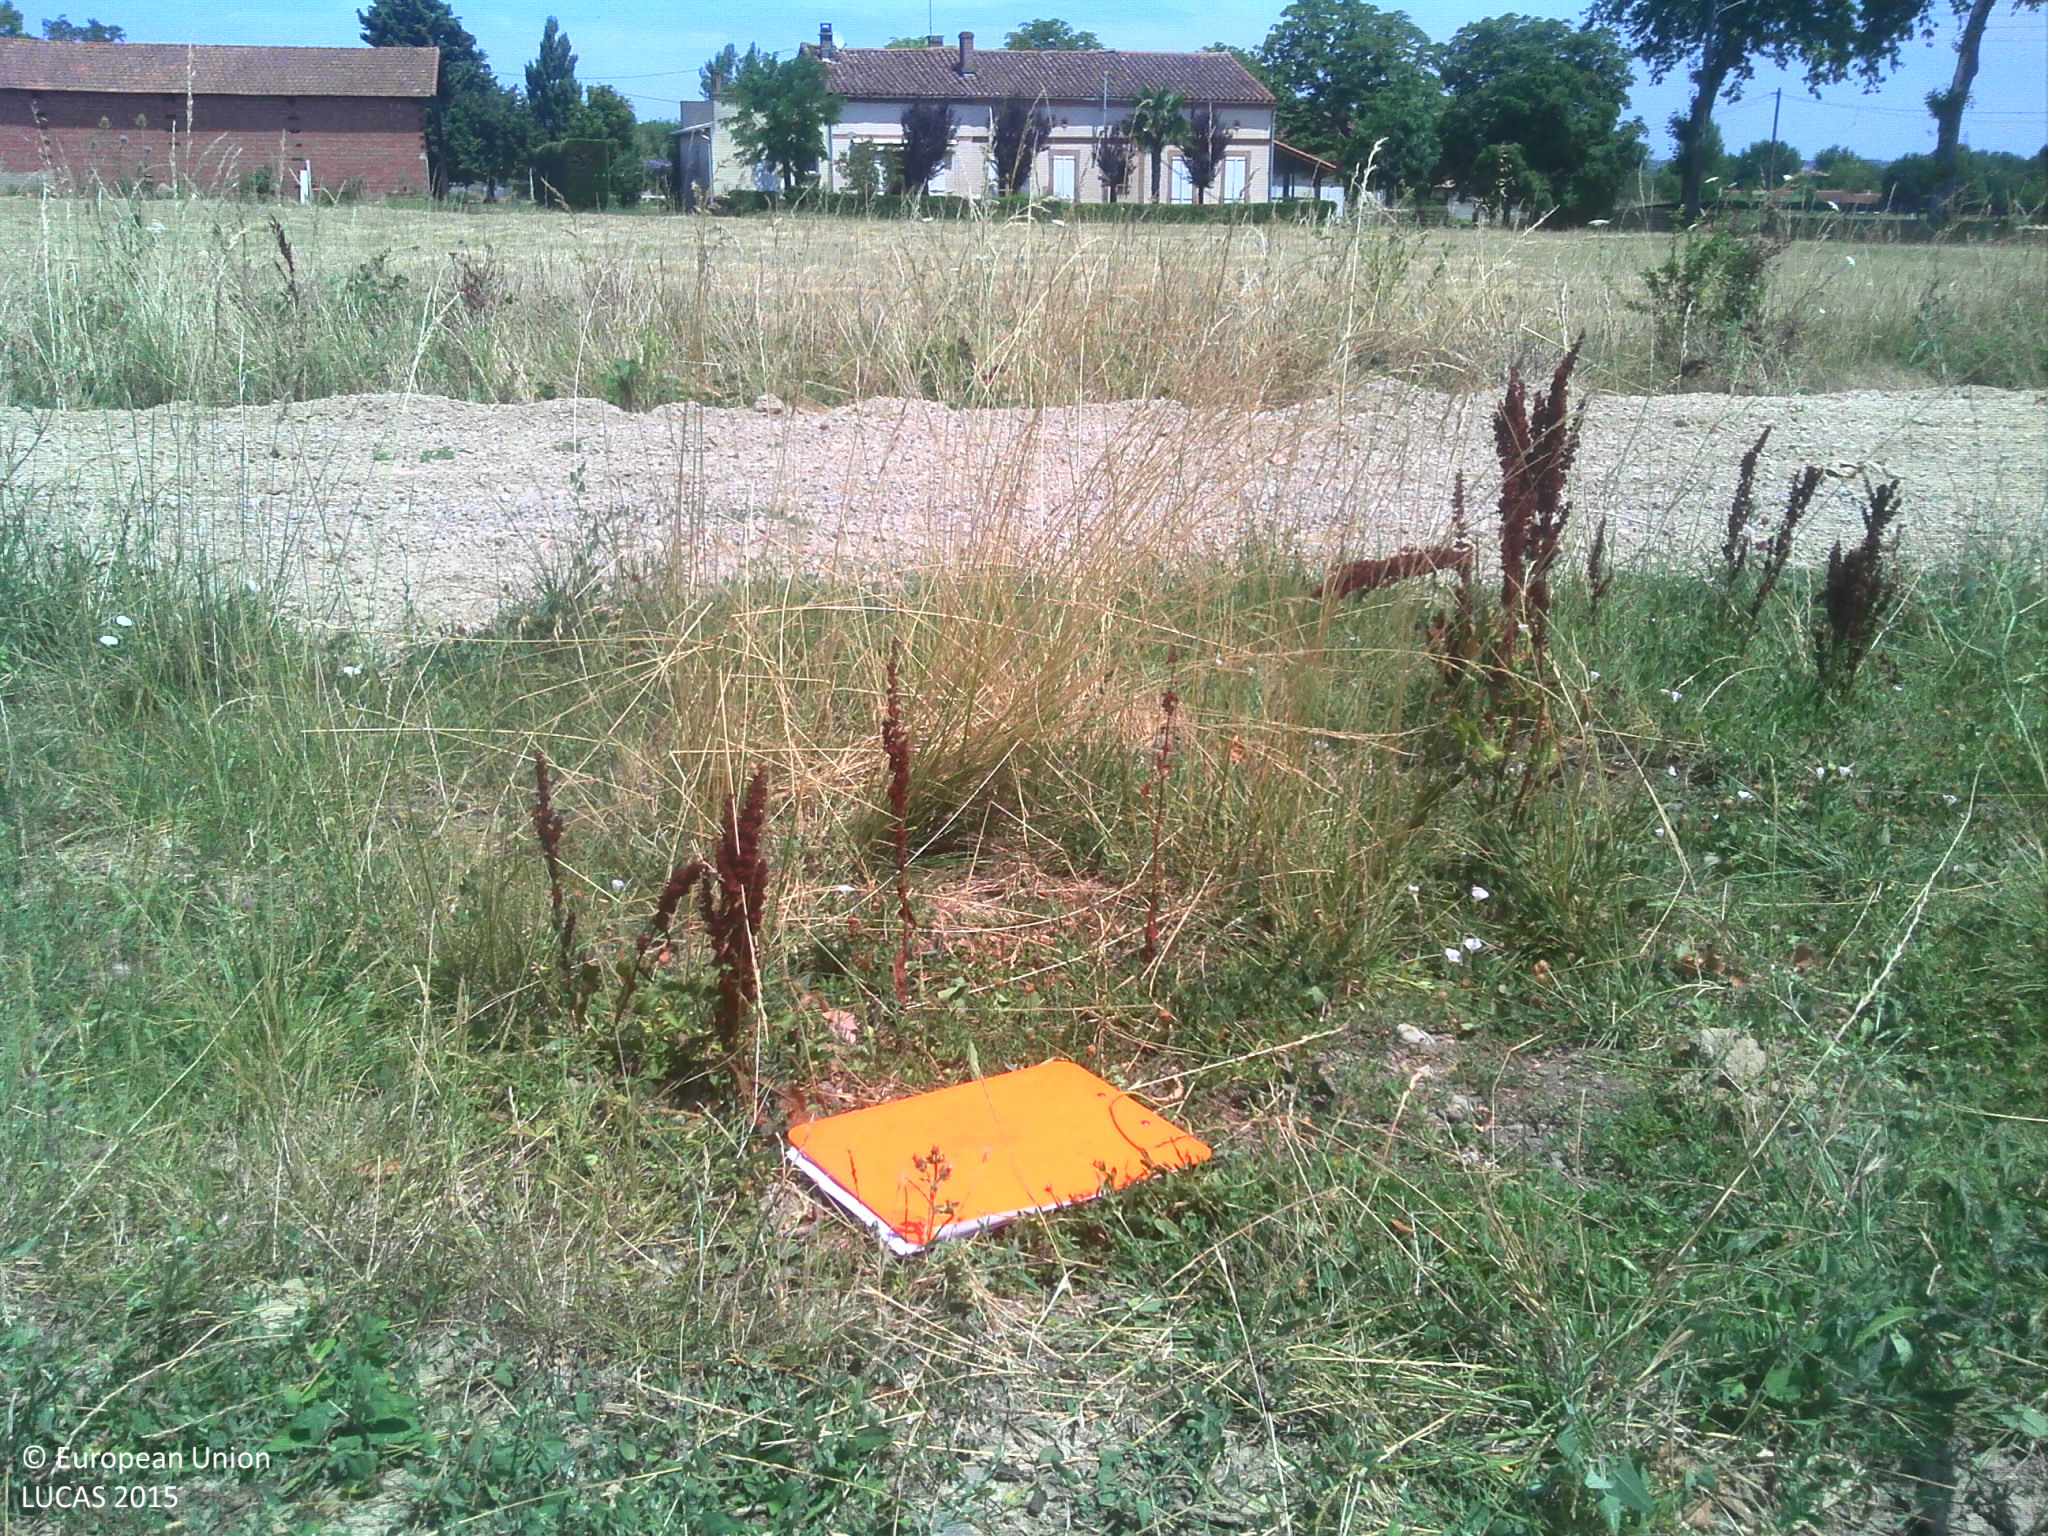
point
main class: Grassland
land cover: Spontaneously vegetated surfaces
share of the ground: > 75 %
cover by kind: herbaceous plants 80 %, consolidated bare surface 20 %
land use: Residential
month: July
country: FR
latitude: 43.4103
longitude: 1.3712
